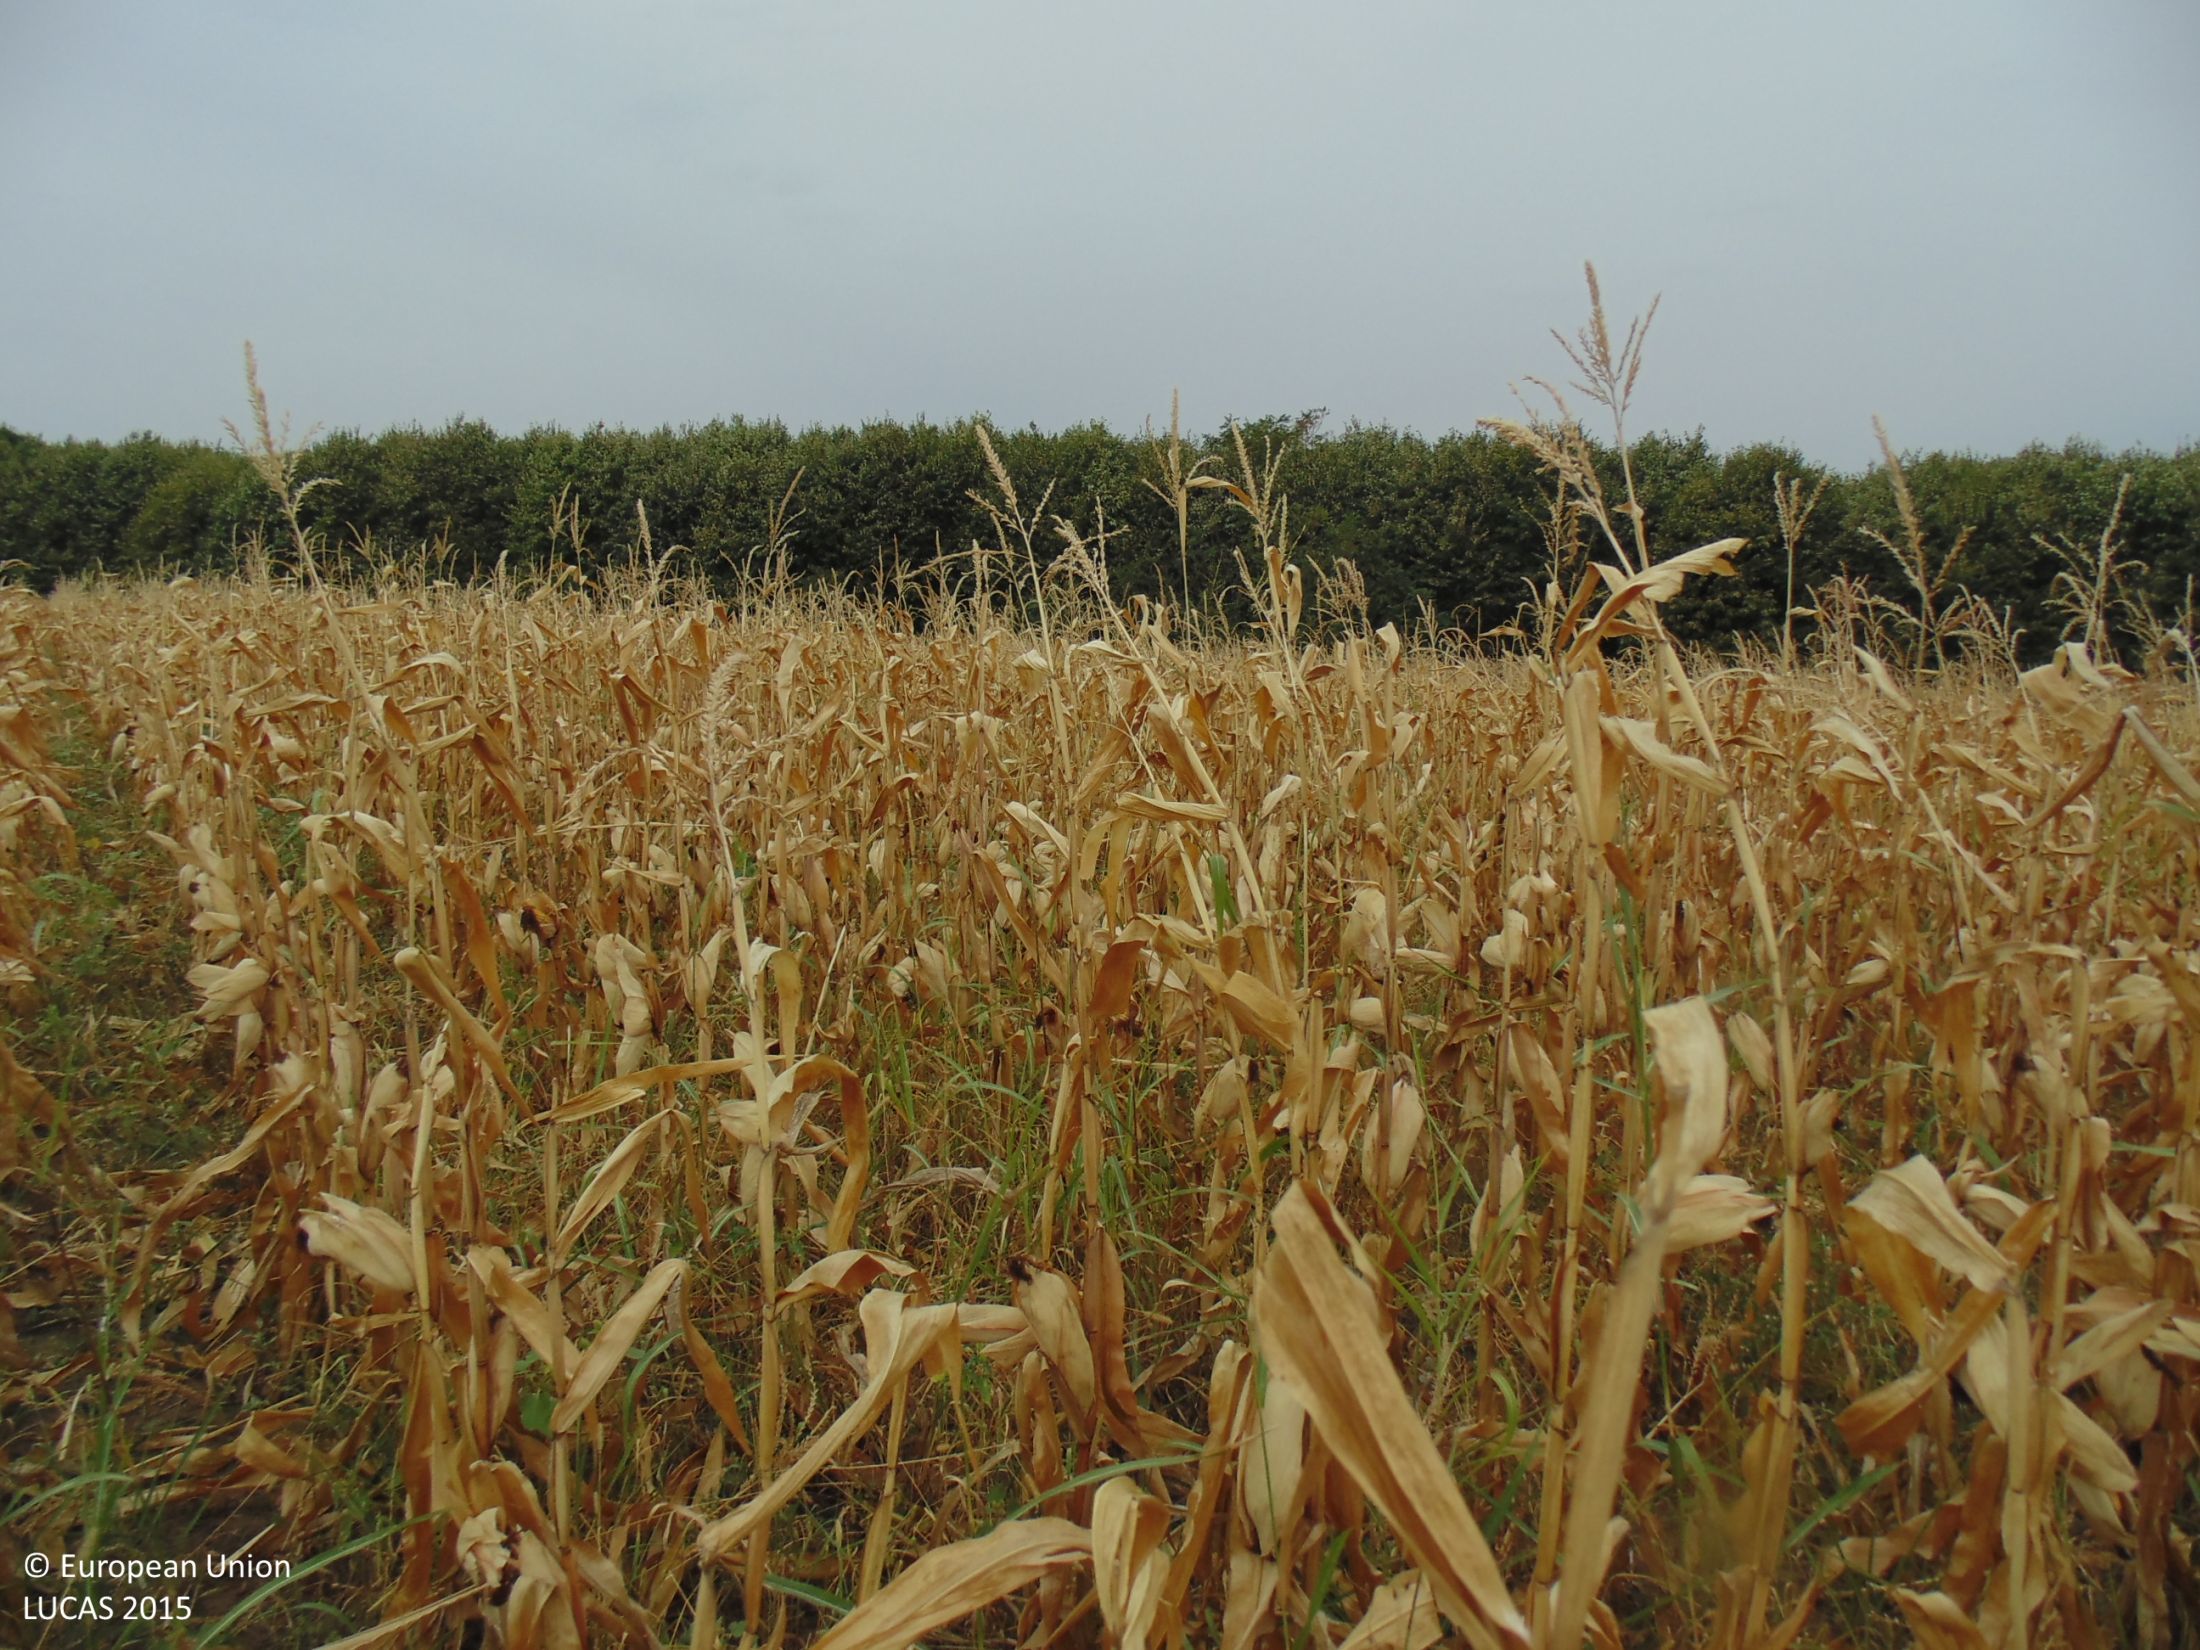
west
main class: Cropland
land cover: Maize
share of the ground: > 75 %
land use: Agriculture (excluding fallow land and kitchen gardens)
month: September
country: BG
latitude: 43.9557
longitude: 27.0597
